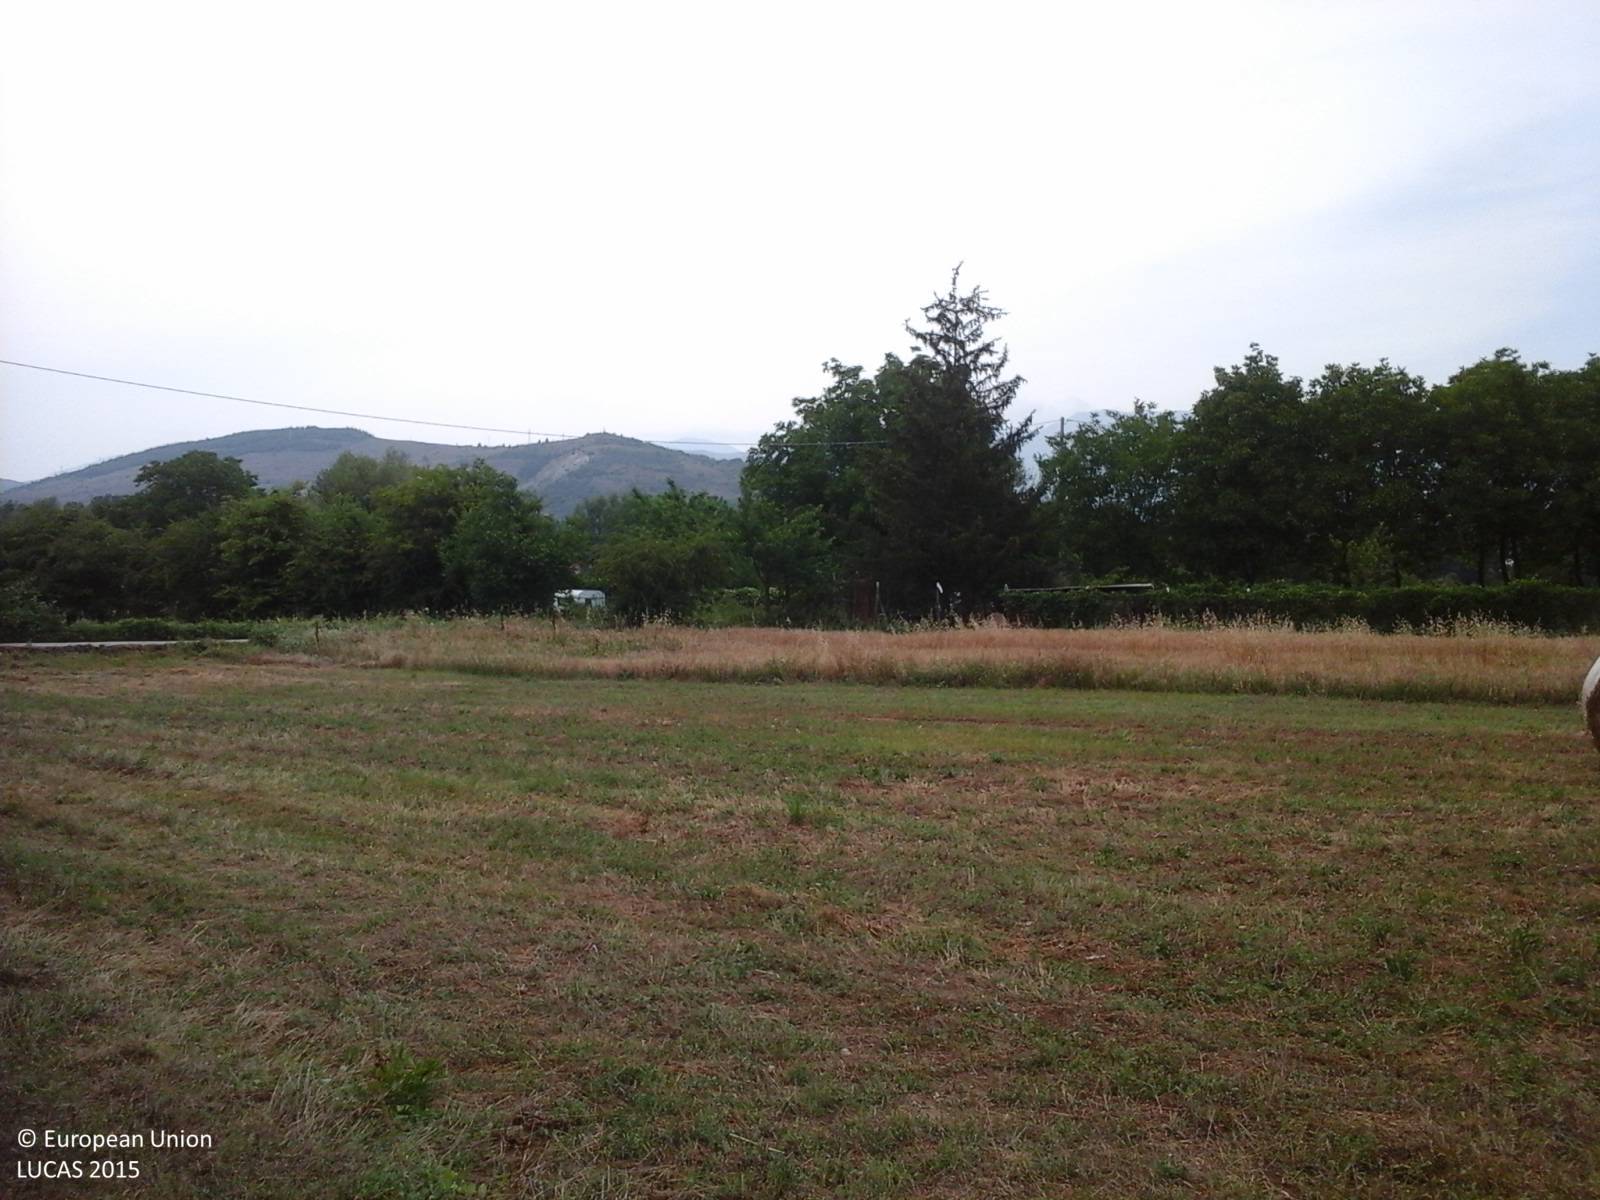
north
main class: Cropland
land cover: Mixed cereals for fodder
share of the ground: > 75 %
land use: Agriculture (excluding fallow land and kitchen gardens)
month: July
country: IT
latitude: 42.3242
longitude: 13.4472
